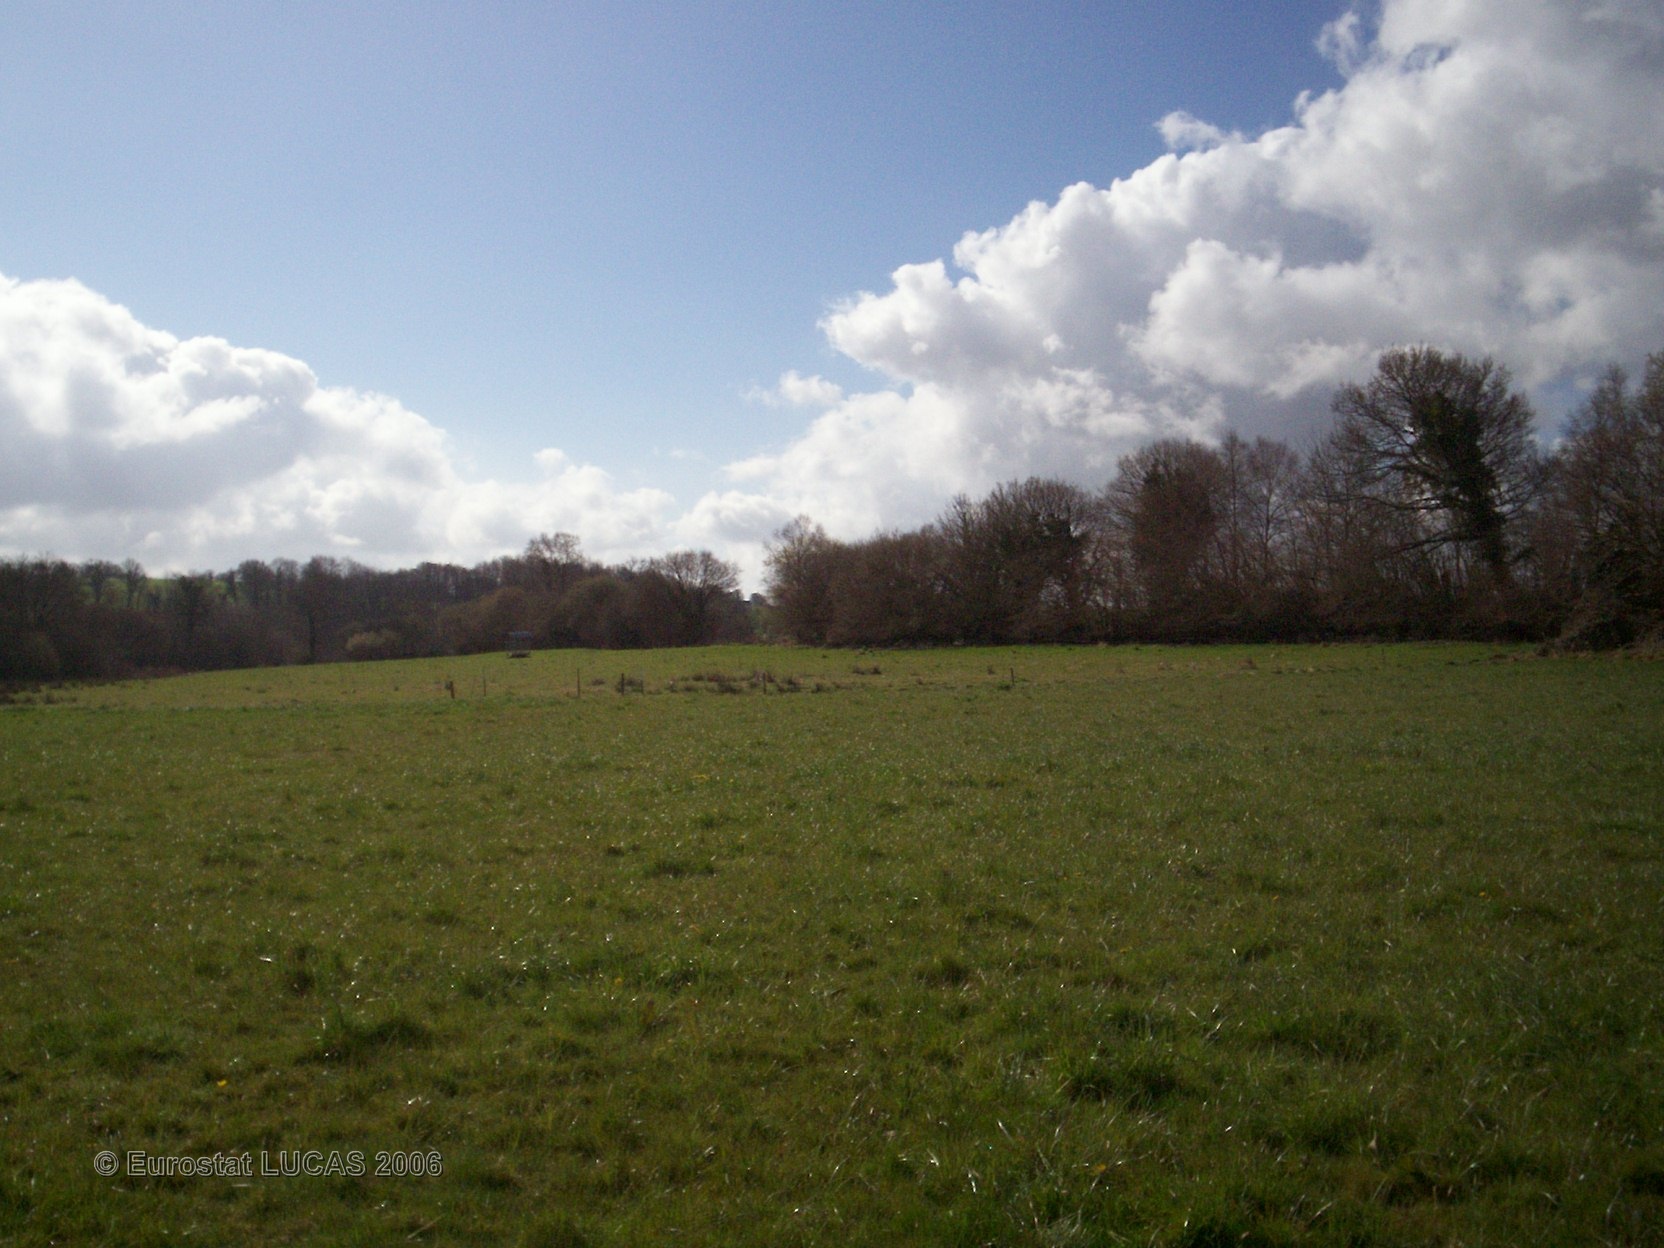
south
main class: Grassland
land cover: Grassland without tree/shrub cover
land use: Agriculture (excluding fallow land and kitchen gardens)
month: April
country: FR
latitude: 48.1340
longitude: -3.6656
